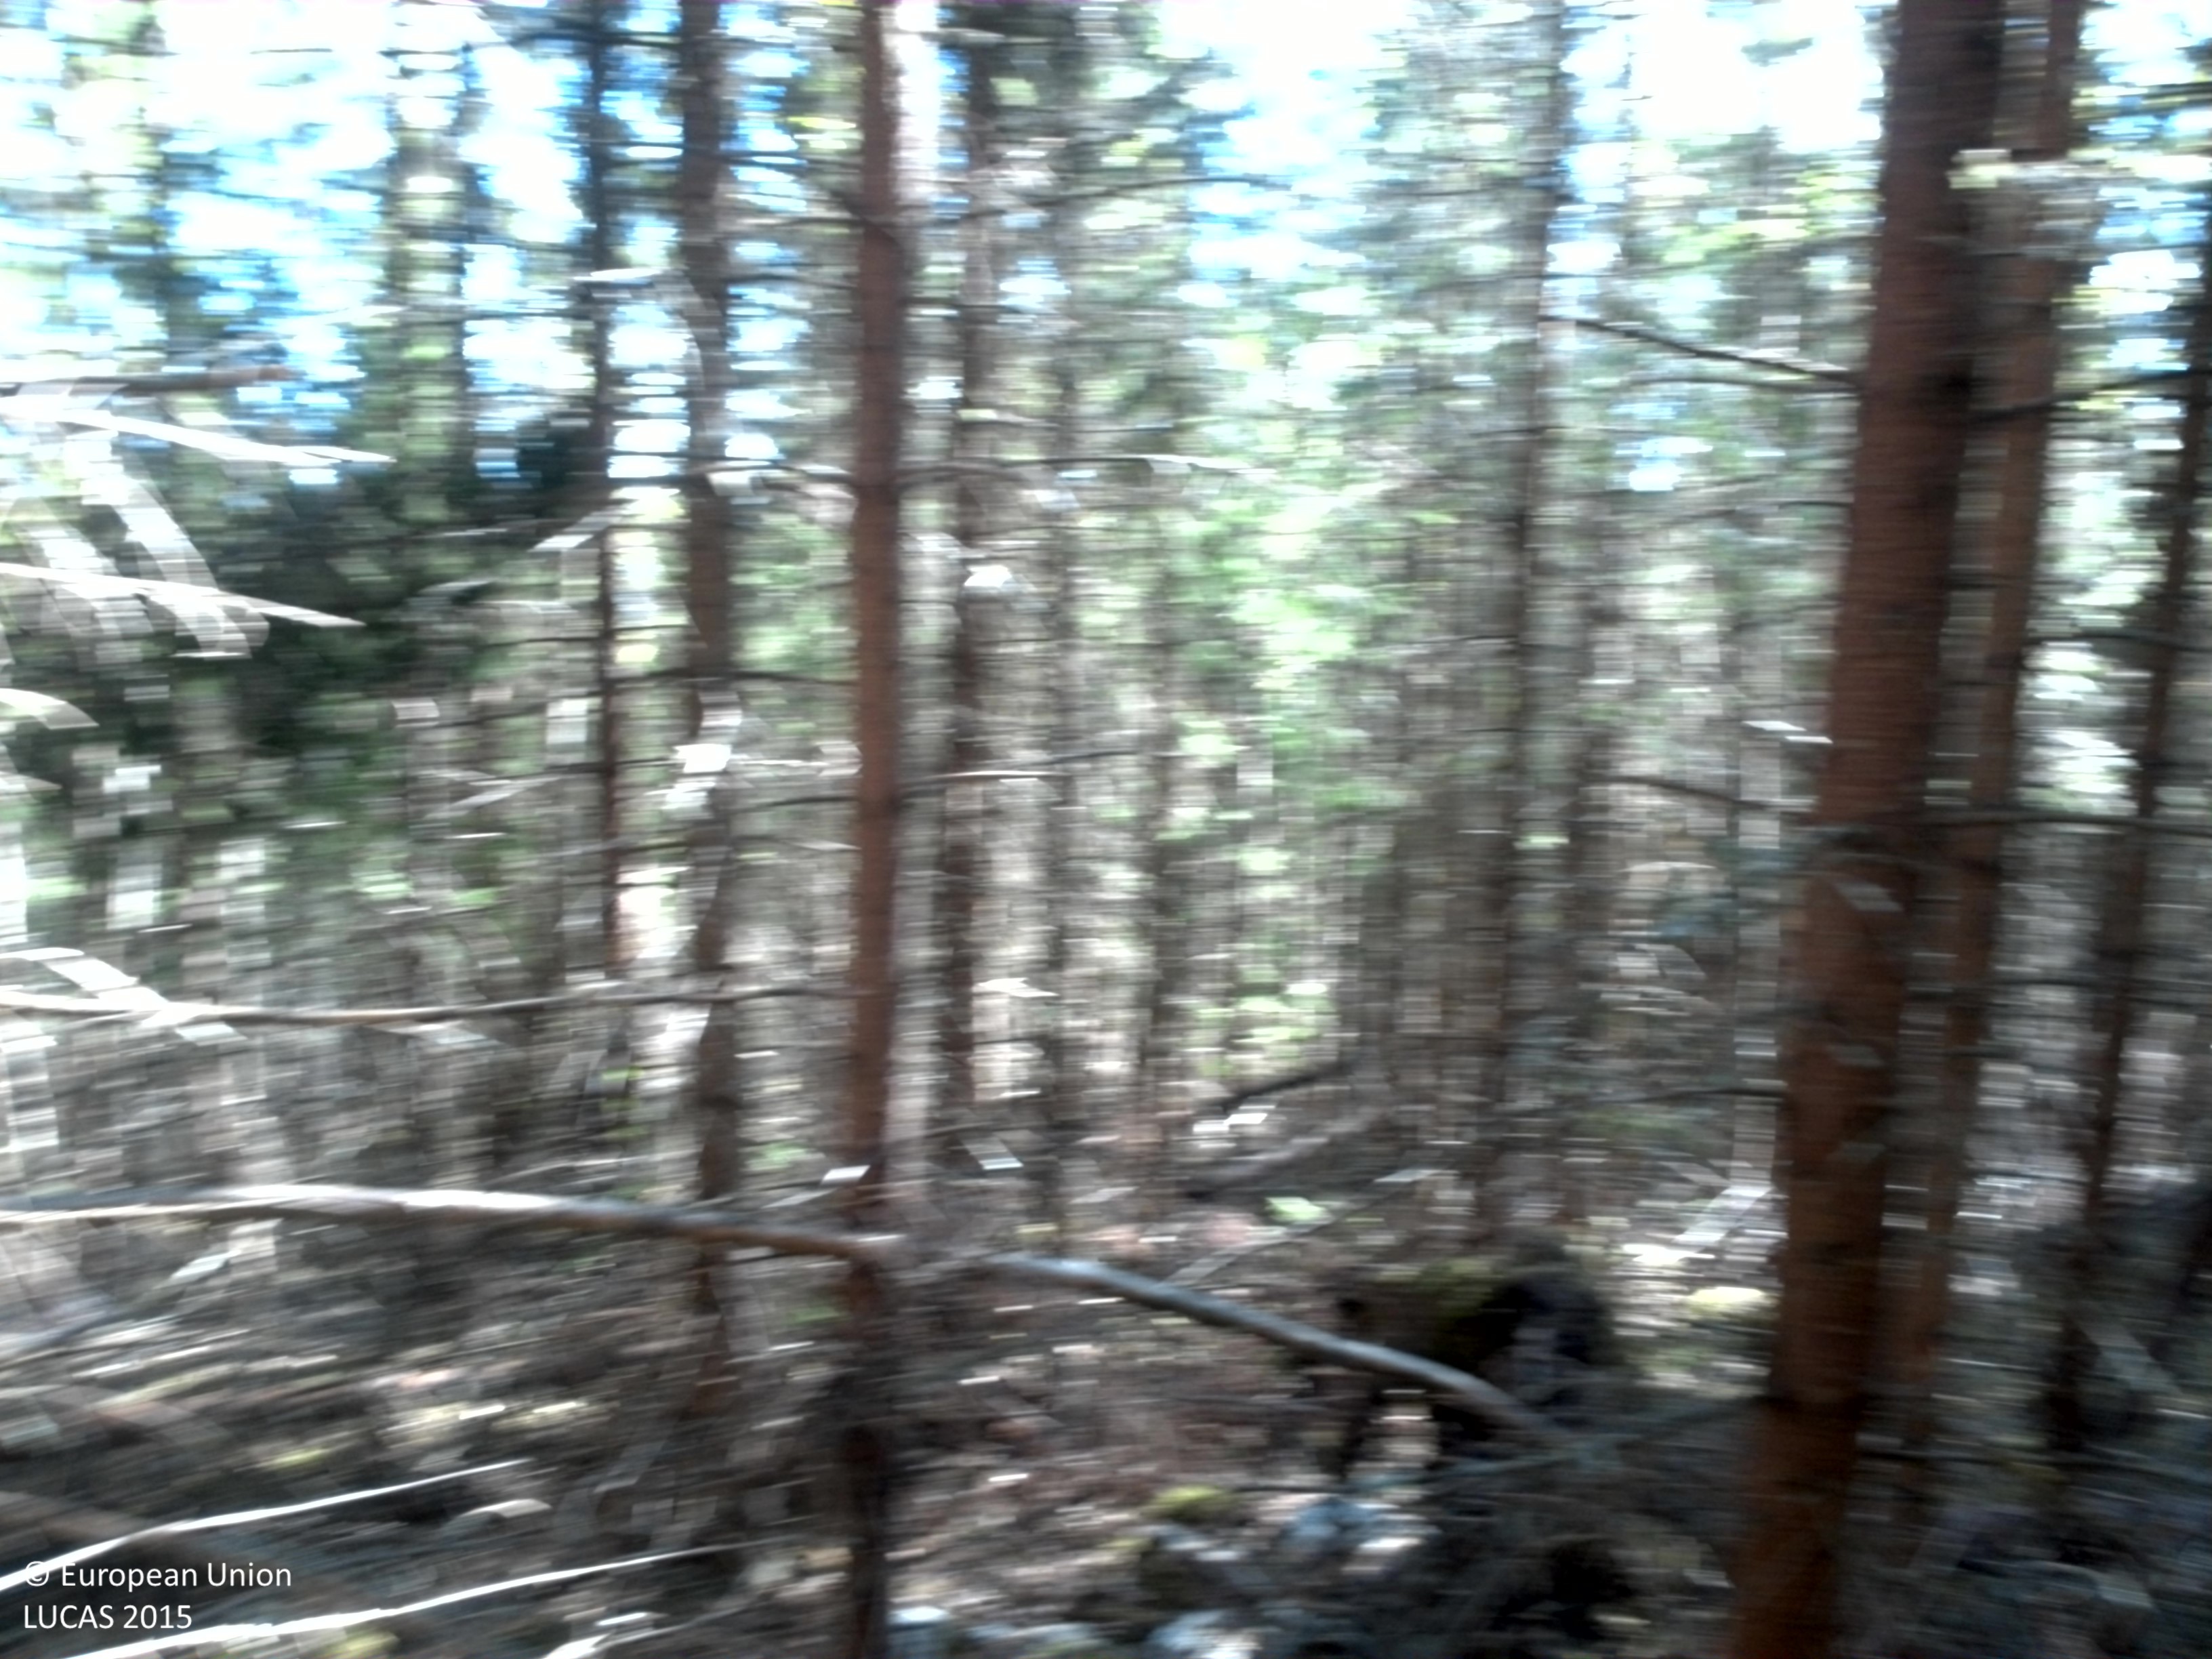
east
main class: Woodland
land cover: Spruce dominated coniferous woodland
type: boreal forest
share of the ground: > 75 %
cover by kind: coniferous forest trees 90 %, lichens and mosses 10 %
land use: Forestry
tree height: > 5 m
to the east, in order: Spruce dominated coniferous woodland; Other mixed woodland; Tracks; Other mixed woodland; Broadleaved woodland
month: May
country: SE
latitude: 63.0155
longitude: 17.6617
